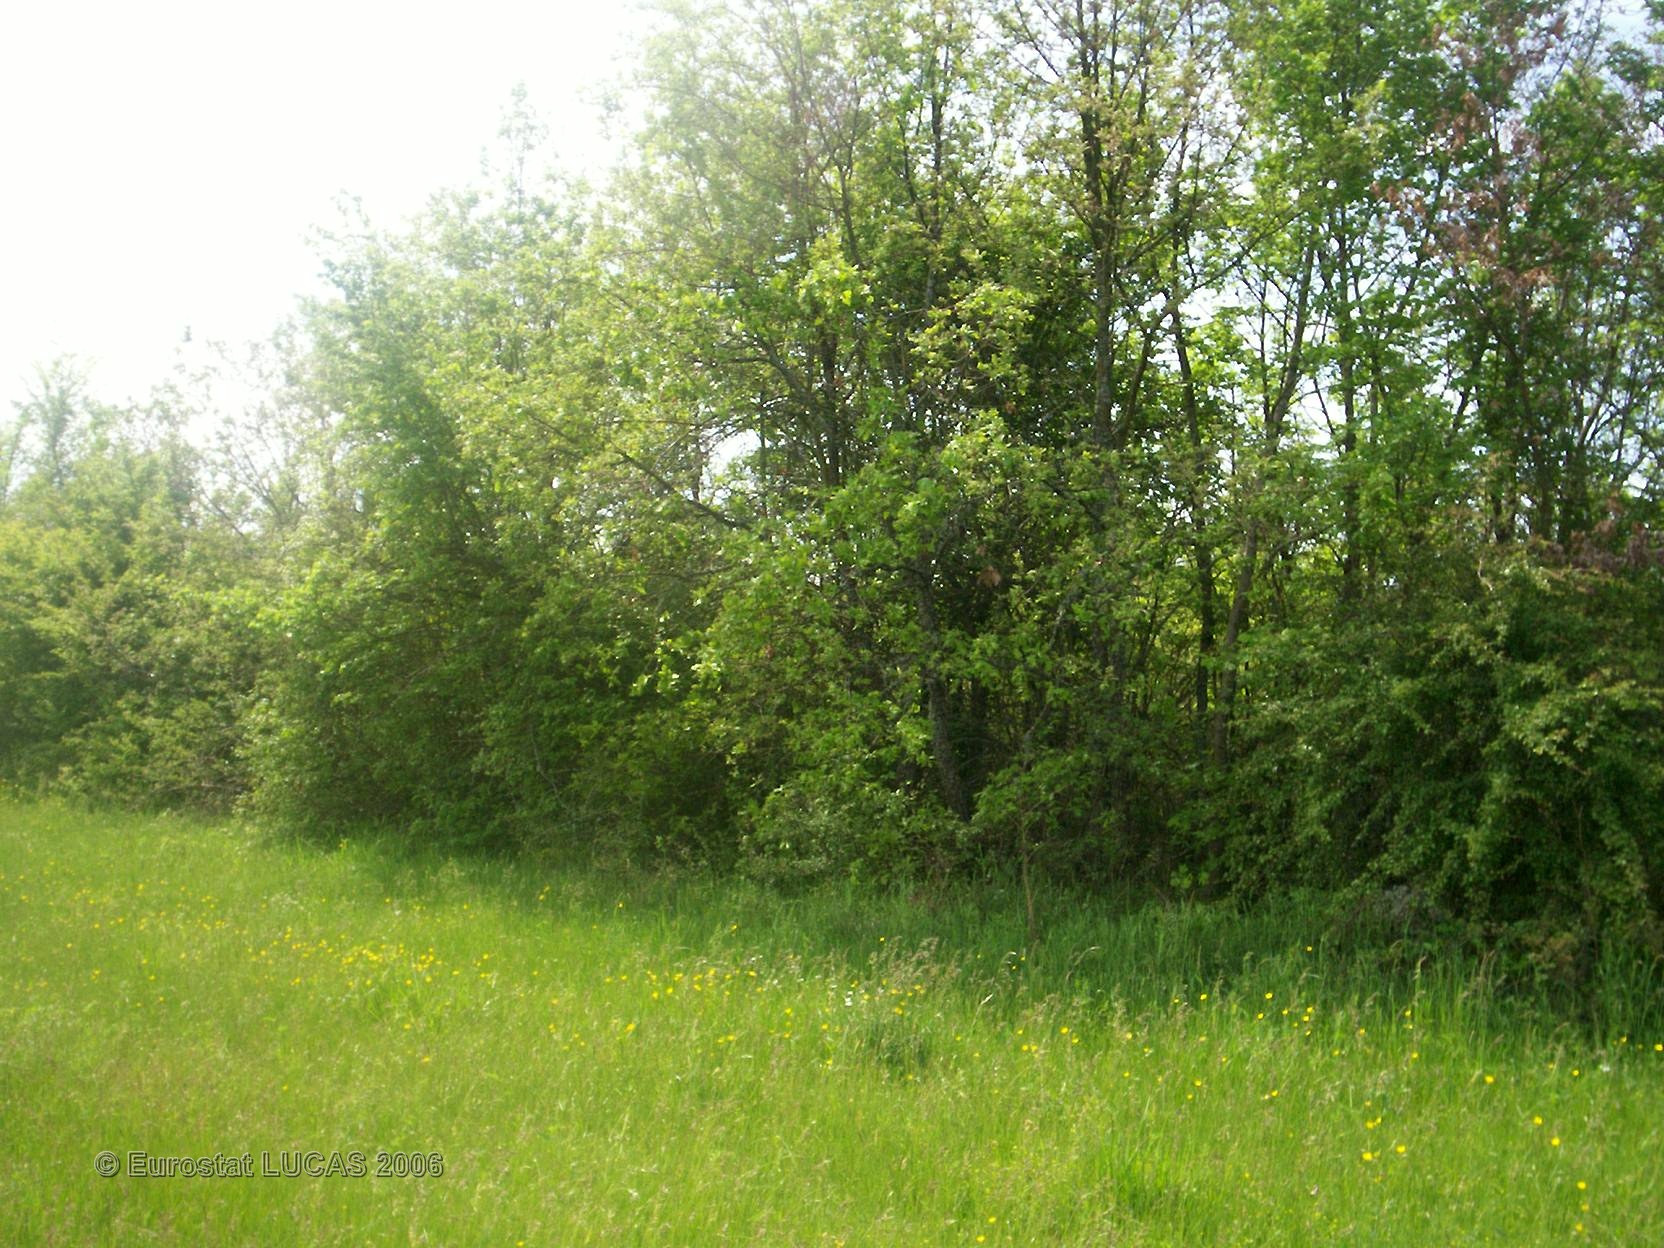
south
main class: Grassland
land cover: Grassland without tree/shrub cover
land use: Agriculture (excluding fallow land and kitchen gardens)
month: May
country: FR
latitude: 45.5040
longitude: 3.2306
